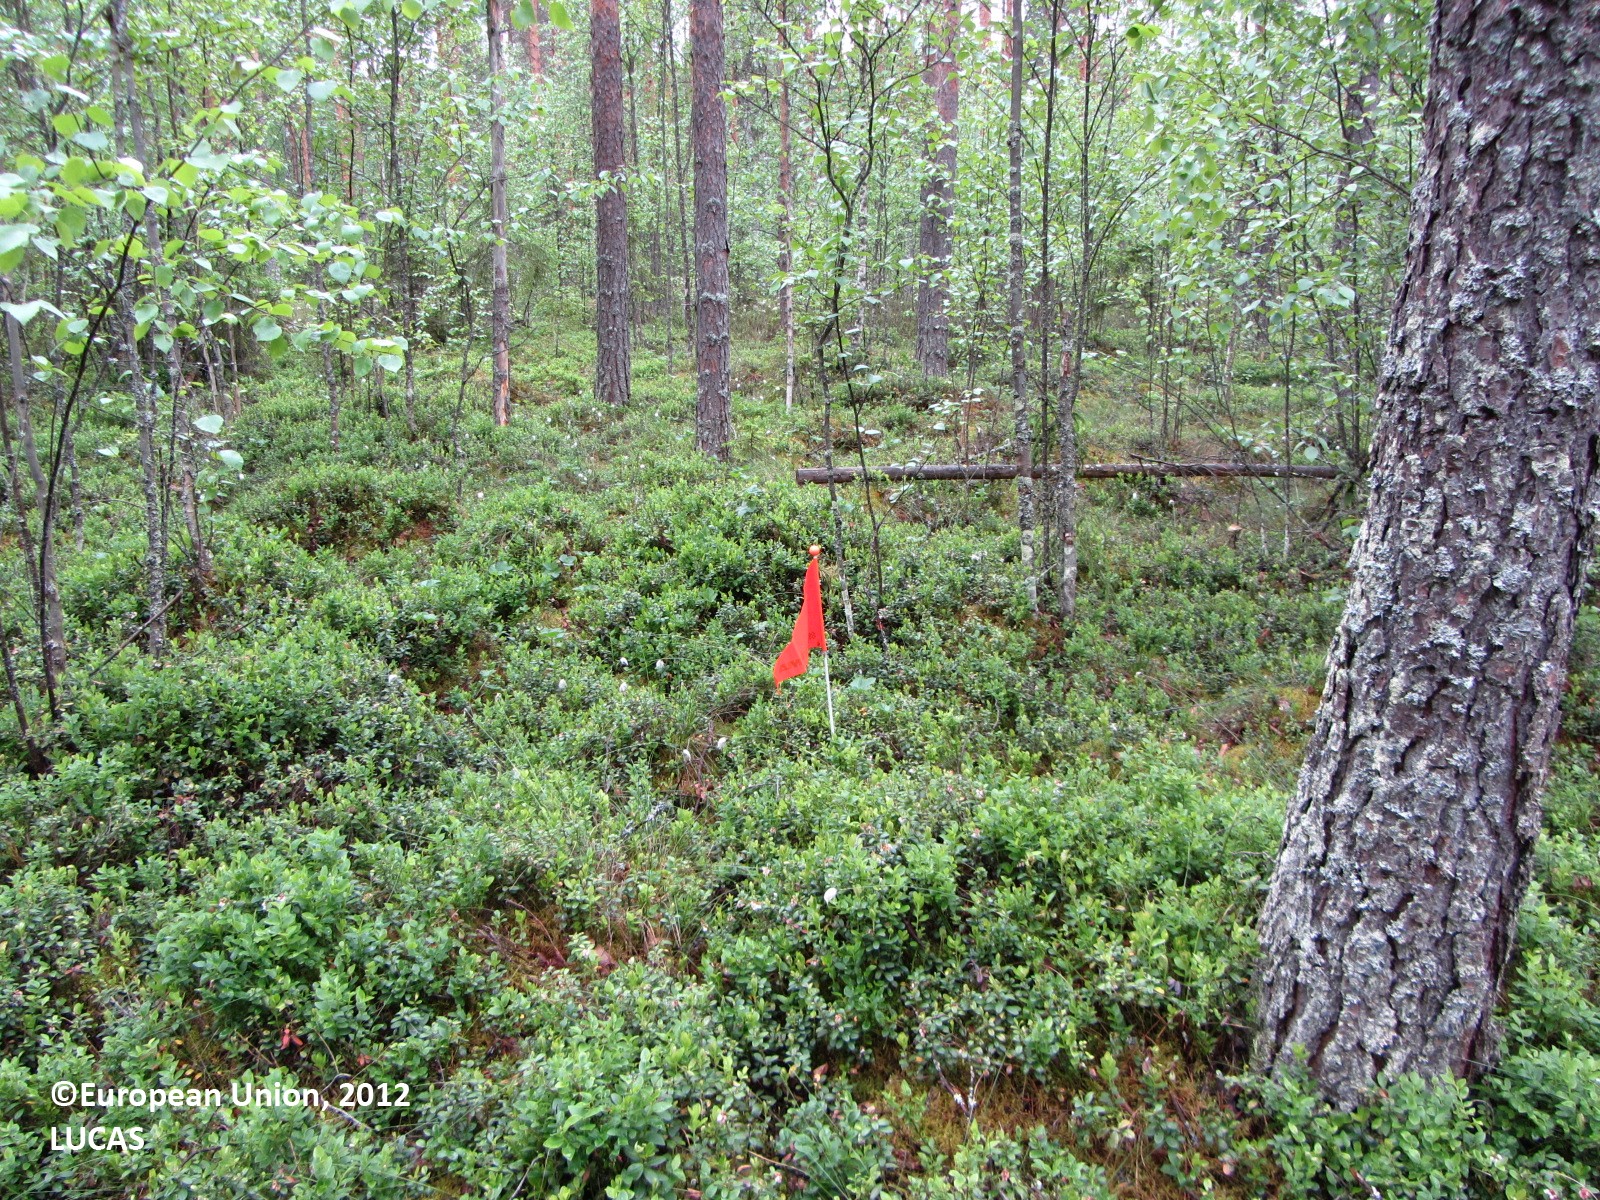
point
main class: Woodland
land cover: Pine dominated mixed woodland
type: boreal forest
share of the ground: 50 - 75 %
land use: Forestry
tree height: > 5 m
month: June
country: FI
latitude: 61.9634
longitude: 25.1948
